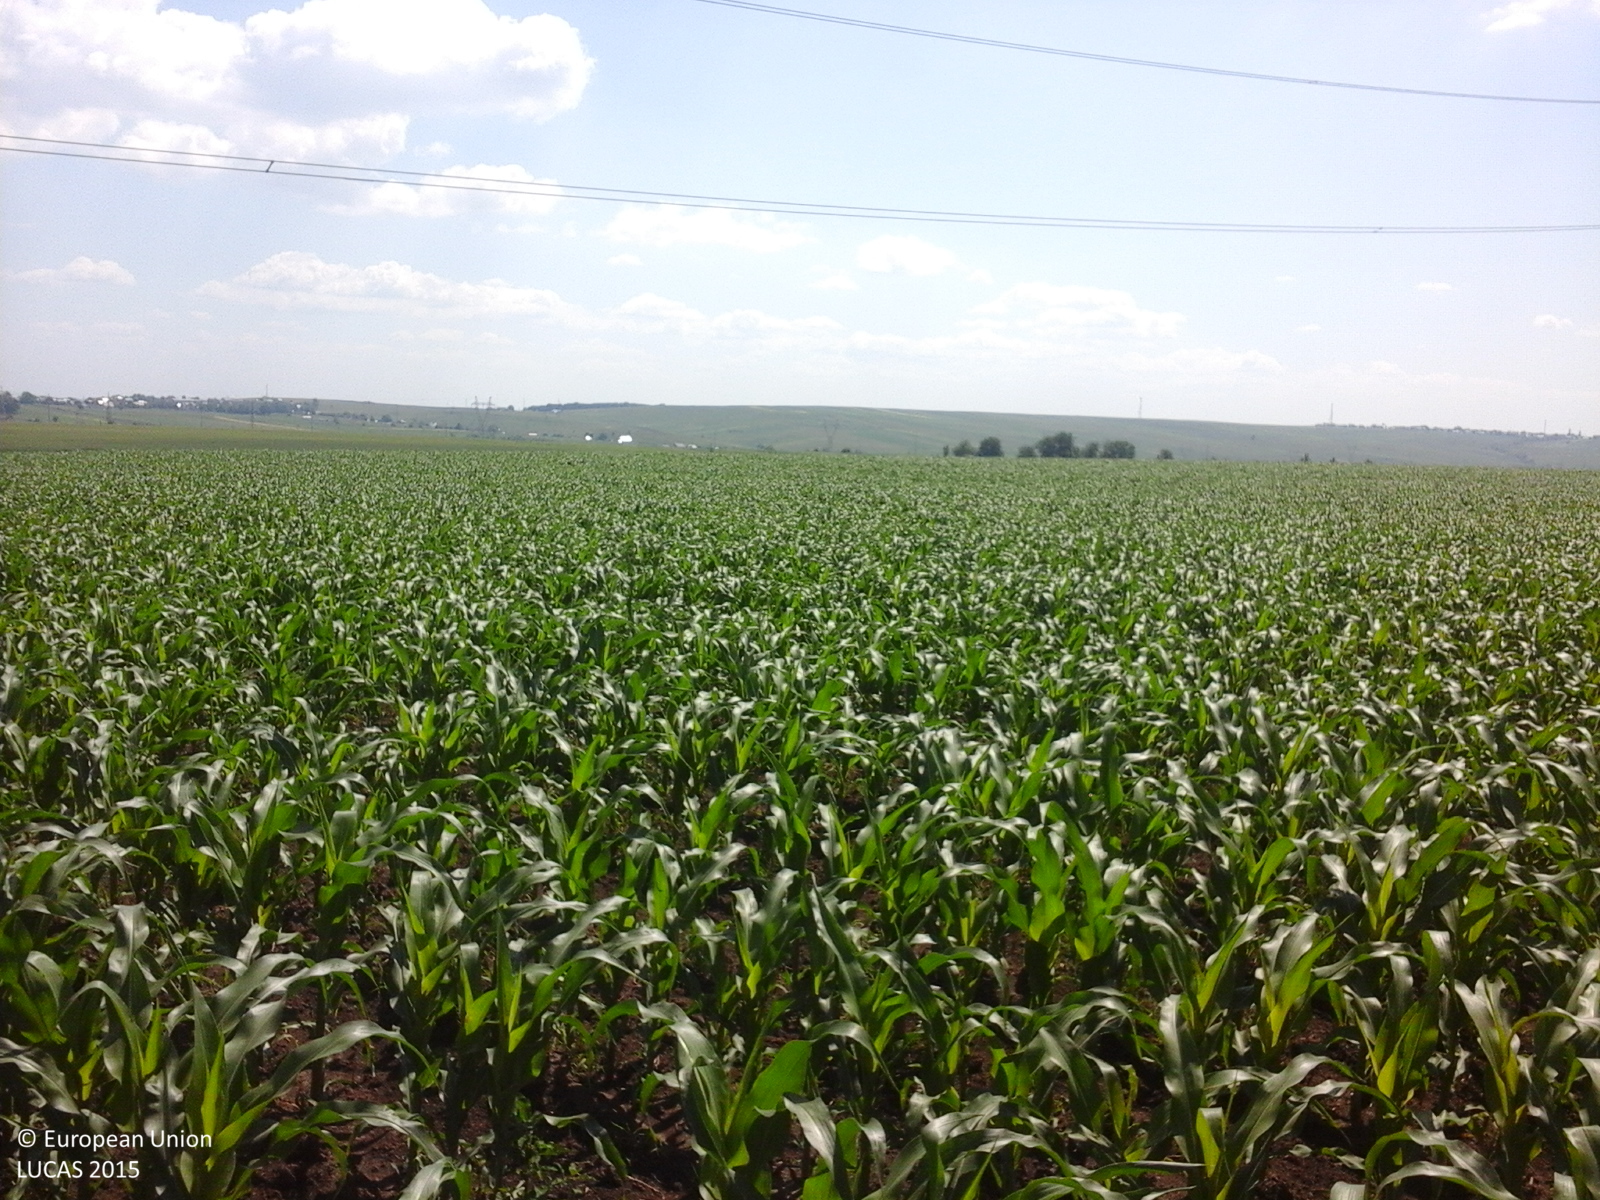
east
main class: Cropland
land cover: Maize
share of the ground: 50 - 75 %
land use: Agriculture (excluding fallow land and kitchen gardens)
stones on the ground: < 10 %
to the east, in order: Maize; Electric lines; Maize
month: June
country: RO
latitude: 47.6133
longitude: 26.2468
